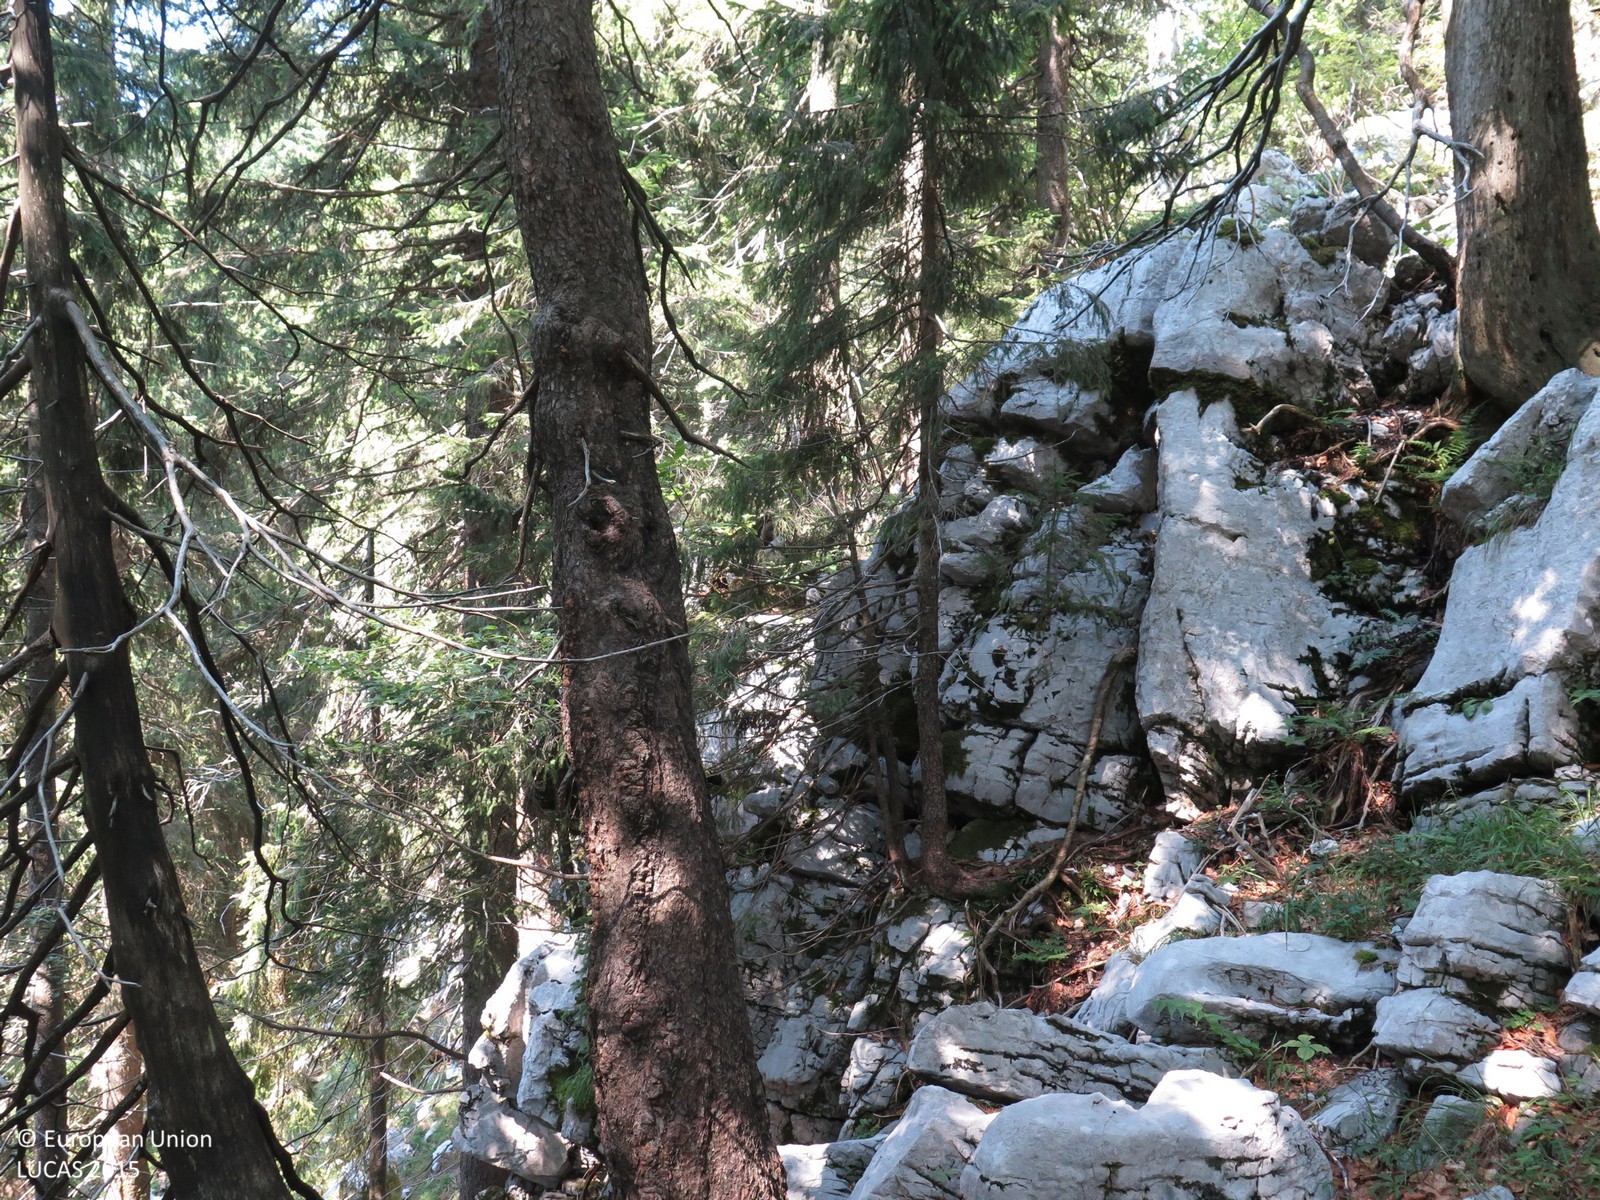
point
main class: Woodland
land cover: Other mixed woodland
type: mountainous beech forest
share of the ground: > 75 %
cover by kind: coniferous forest trees 65 %, broadleaved forest trees 25 %, consolidated bare surface 10 %
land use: Forestry
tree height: > 5 m
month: August
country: HR
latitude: 45.4971
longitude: 14.5383
